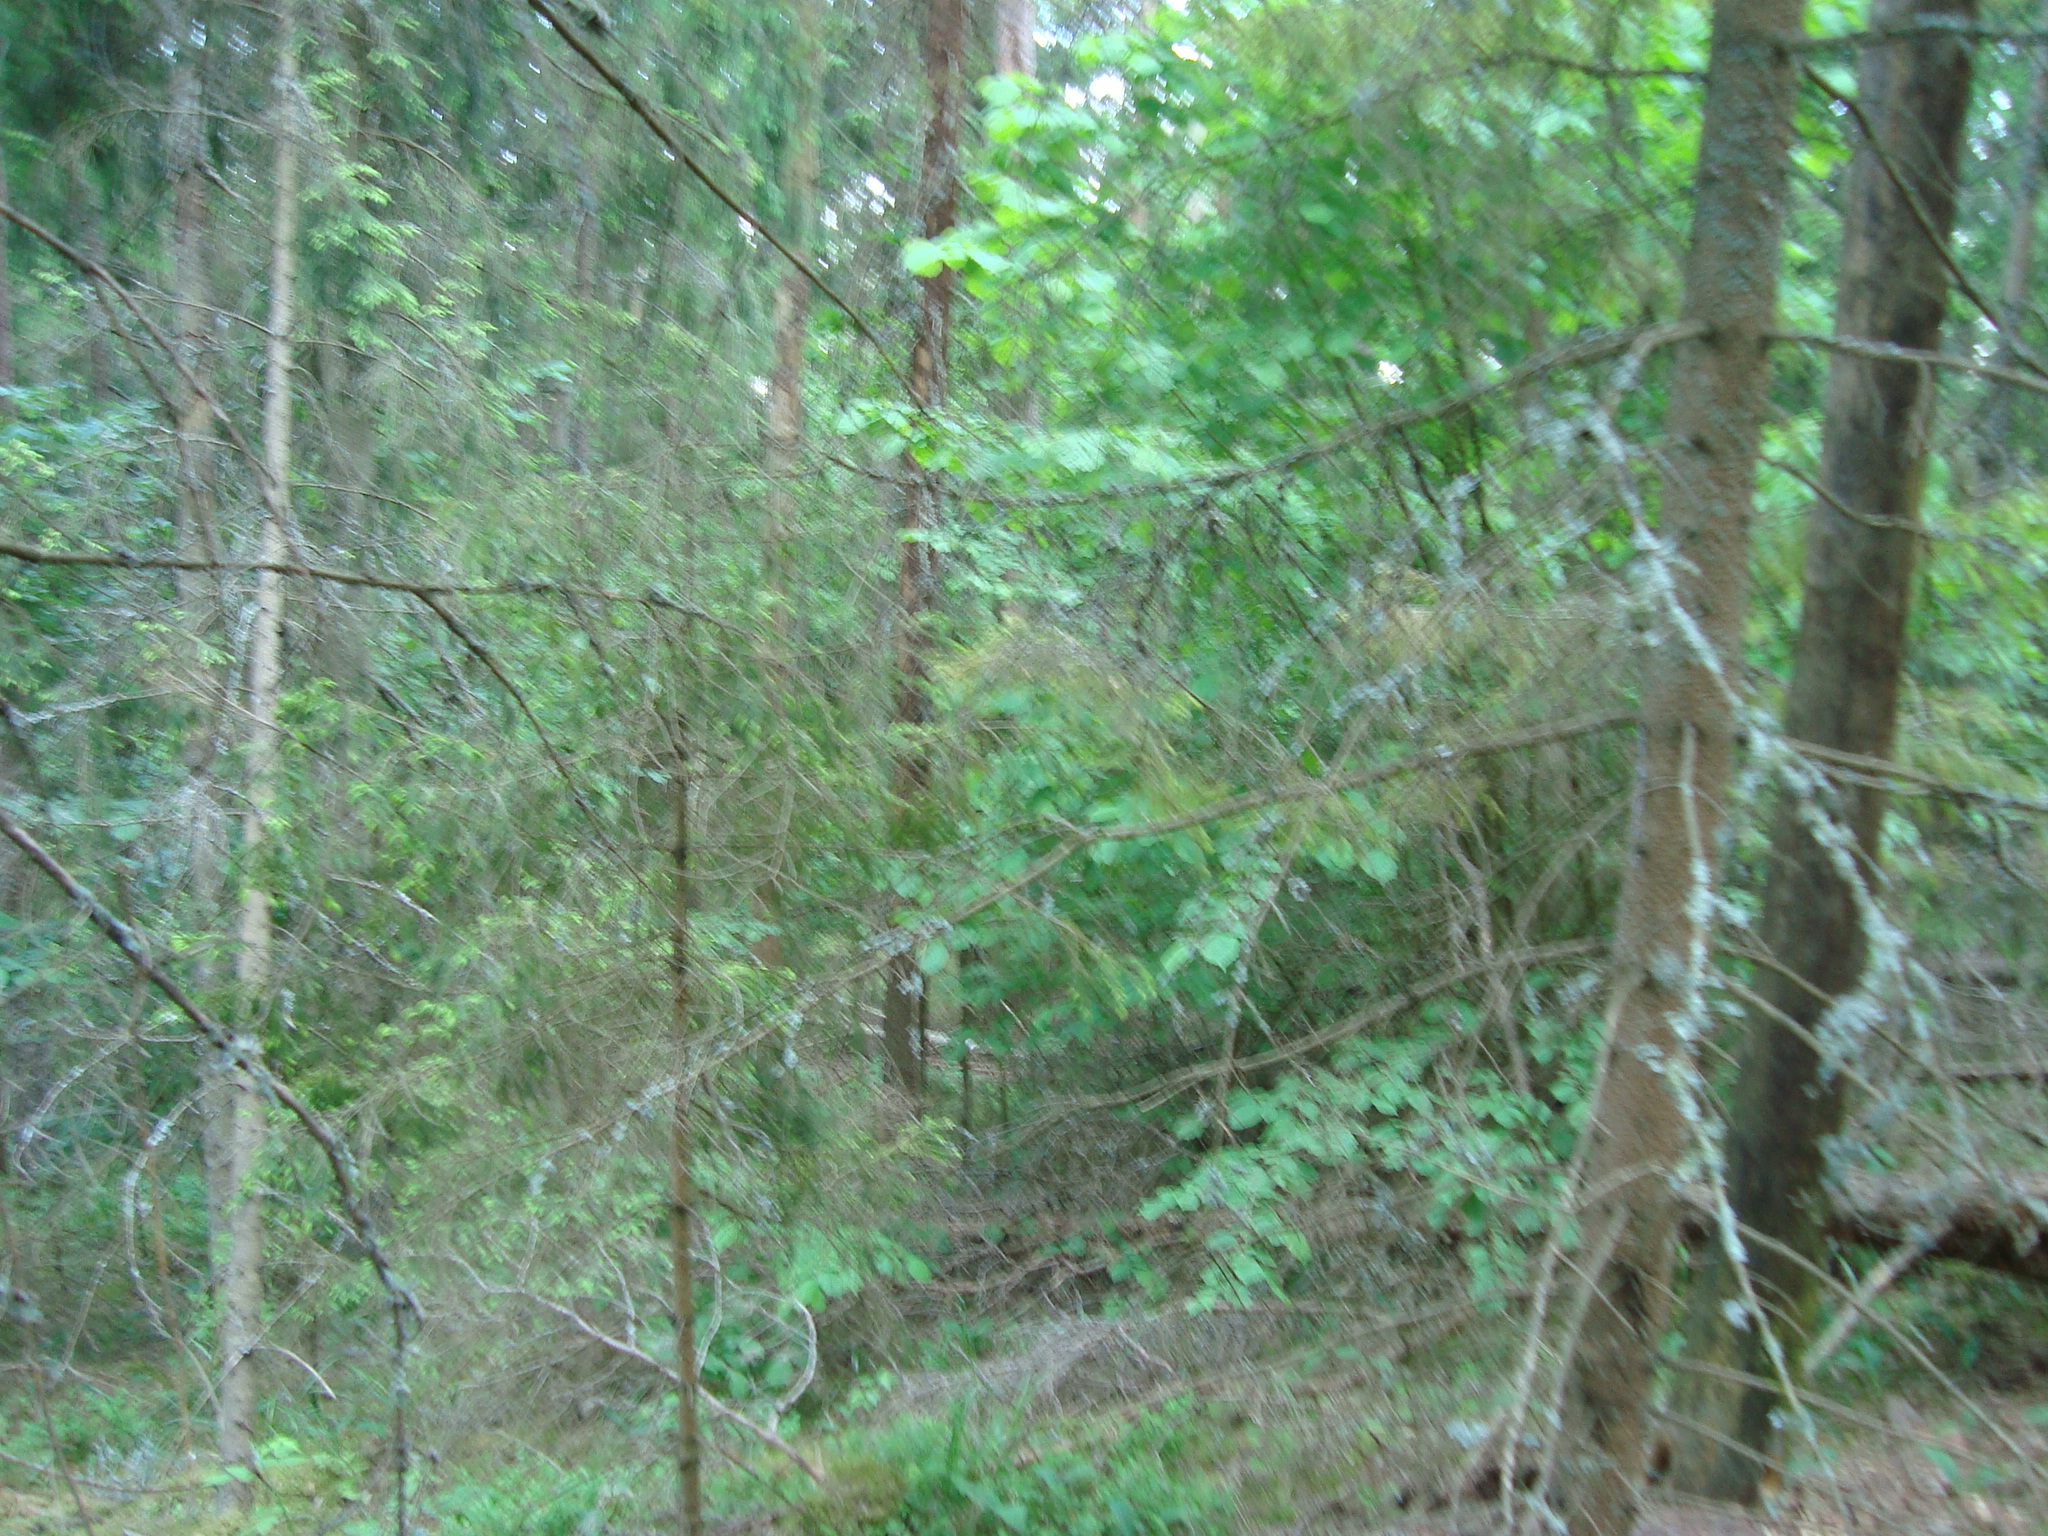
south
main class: Woodland
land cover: Spruce dominated coniferous woodland
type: hemiboreal forest and nemoral coniferous forest and mixed broadleaved-coniferous forest
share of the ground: > 75 %
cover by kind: coniferous forest trees 80 %, herbaceous plants 10 %, broadleaved forest trees 5 %, lichens and mosses 5 %
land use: Forestry
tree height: > 5 m
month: June
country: LV
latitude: 56.6934
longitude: 25.7523
